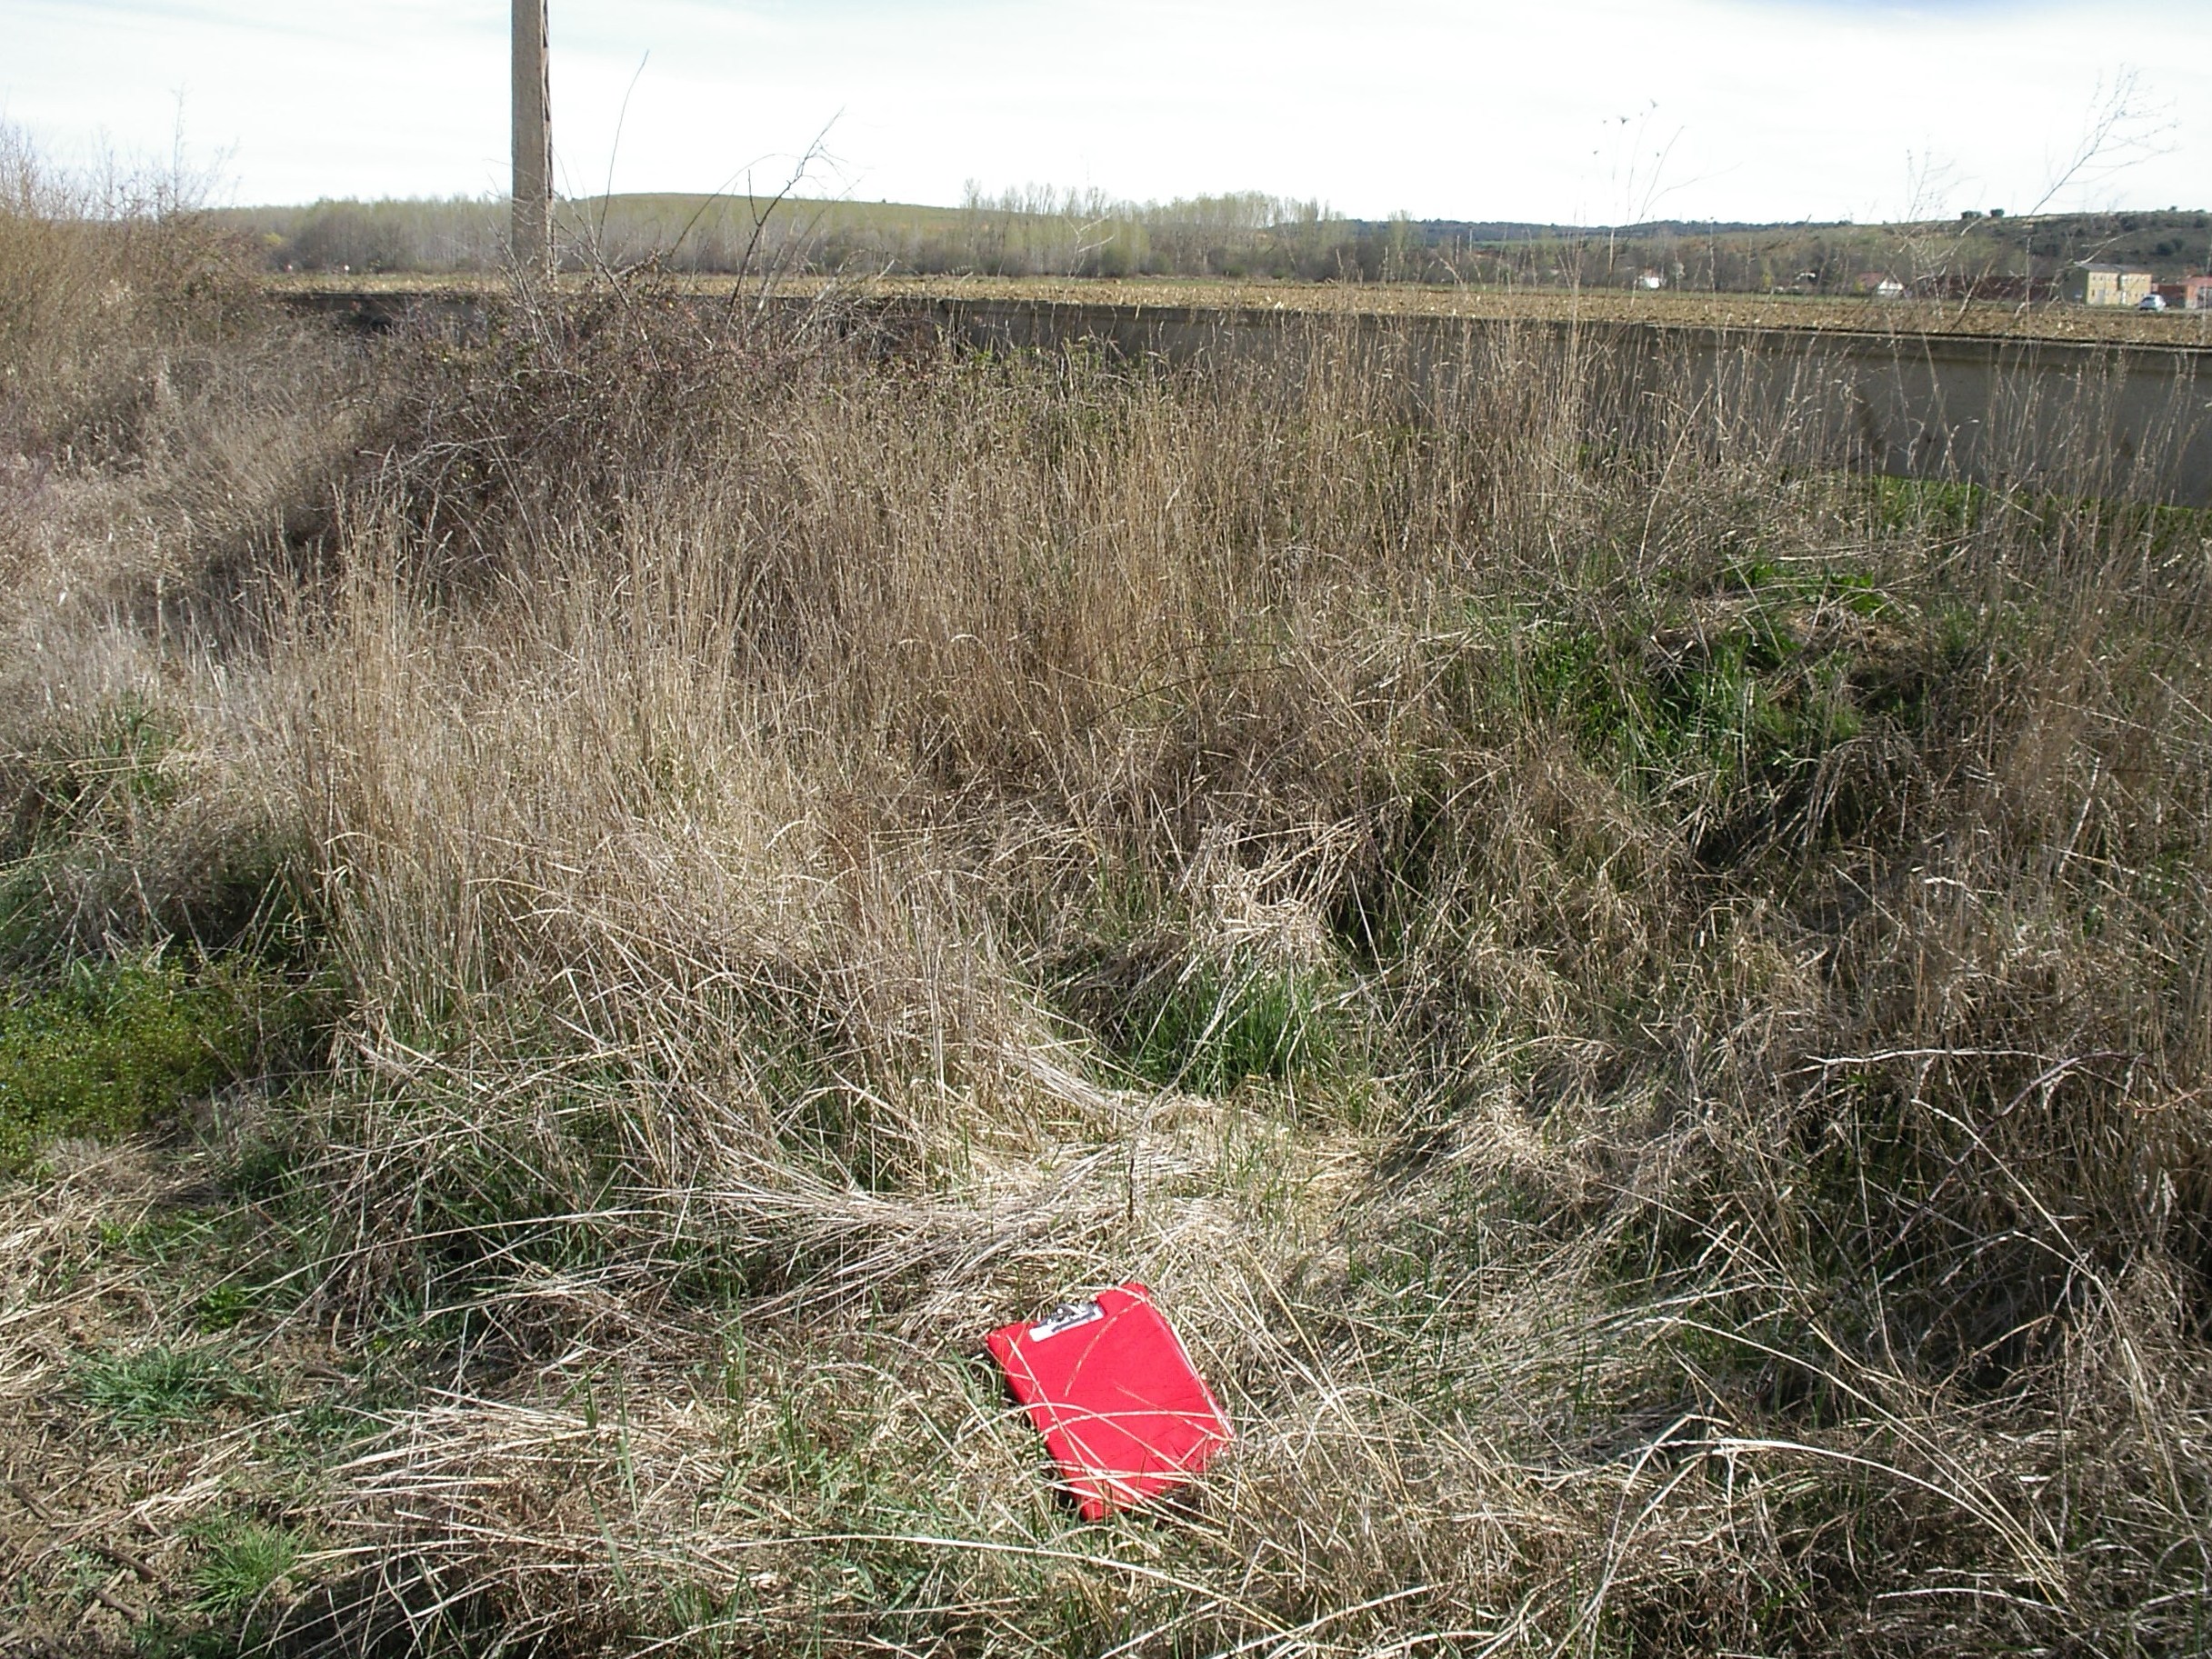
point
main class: Grassland
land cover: Grassland without tree/shrub cover
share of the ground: 10 - 25 %
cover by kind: herbaceous plants 50 %, unconsolidated bare surface 20 %
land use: Railway transport
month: April
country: ES
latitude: 42.4844
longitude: -6.0552
